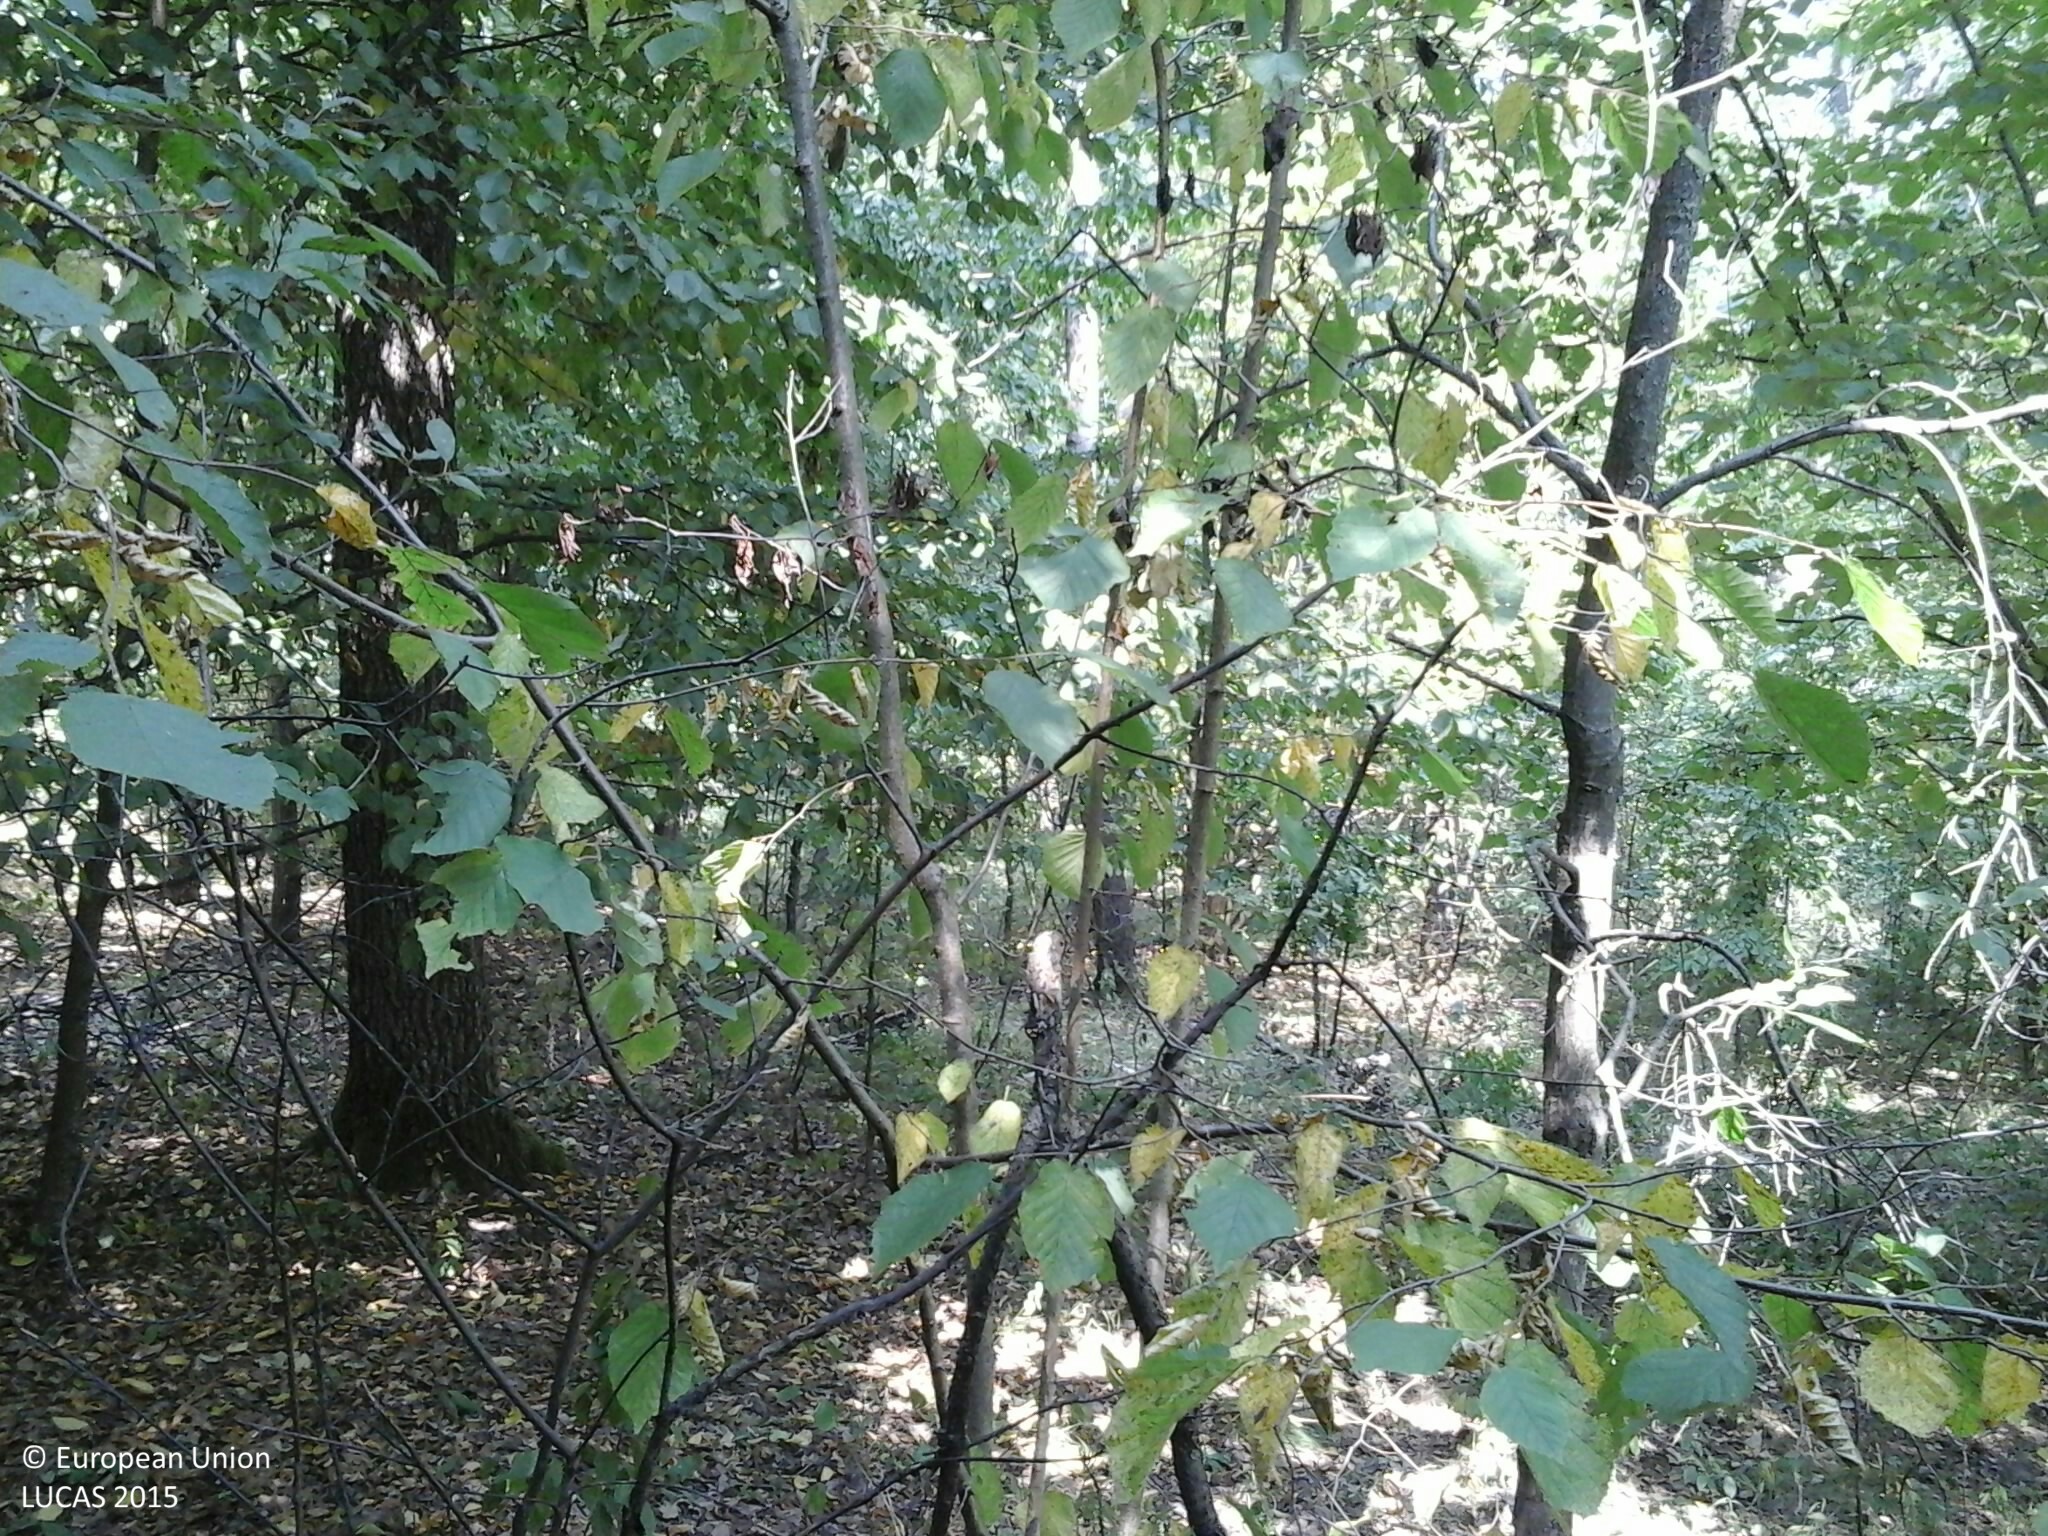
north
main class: Woodland
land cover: Broadleaved woodland
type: mesophytic deciduous forest
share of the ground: > 75 %
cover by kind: broadleaved forest trees 100 %
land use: Forestry
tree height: > 5 m
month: August
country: HU
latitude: 48.4453
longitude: 20.5121
